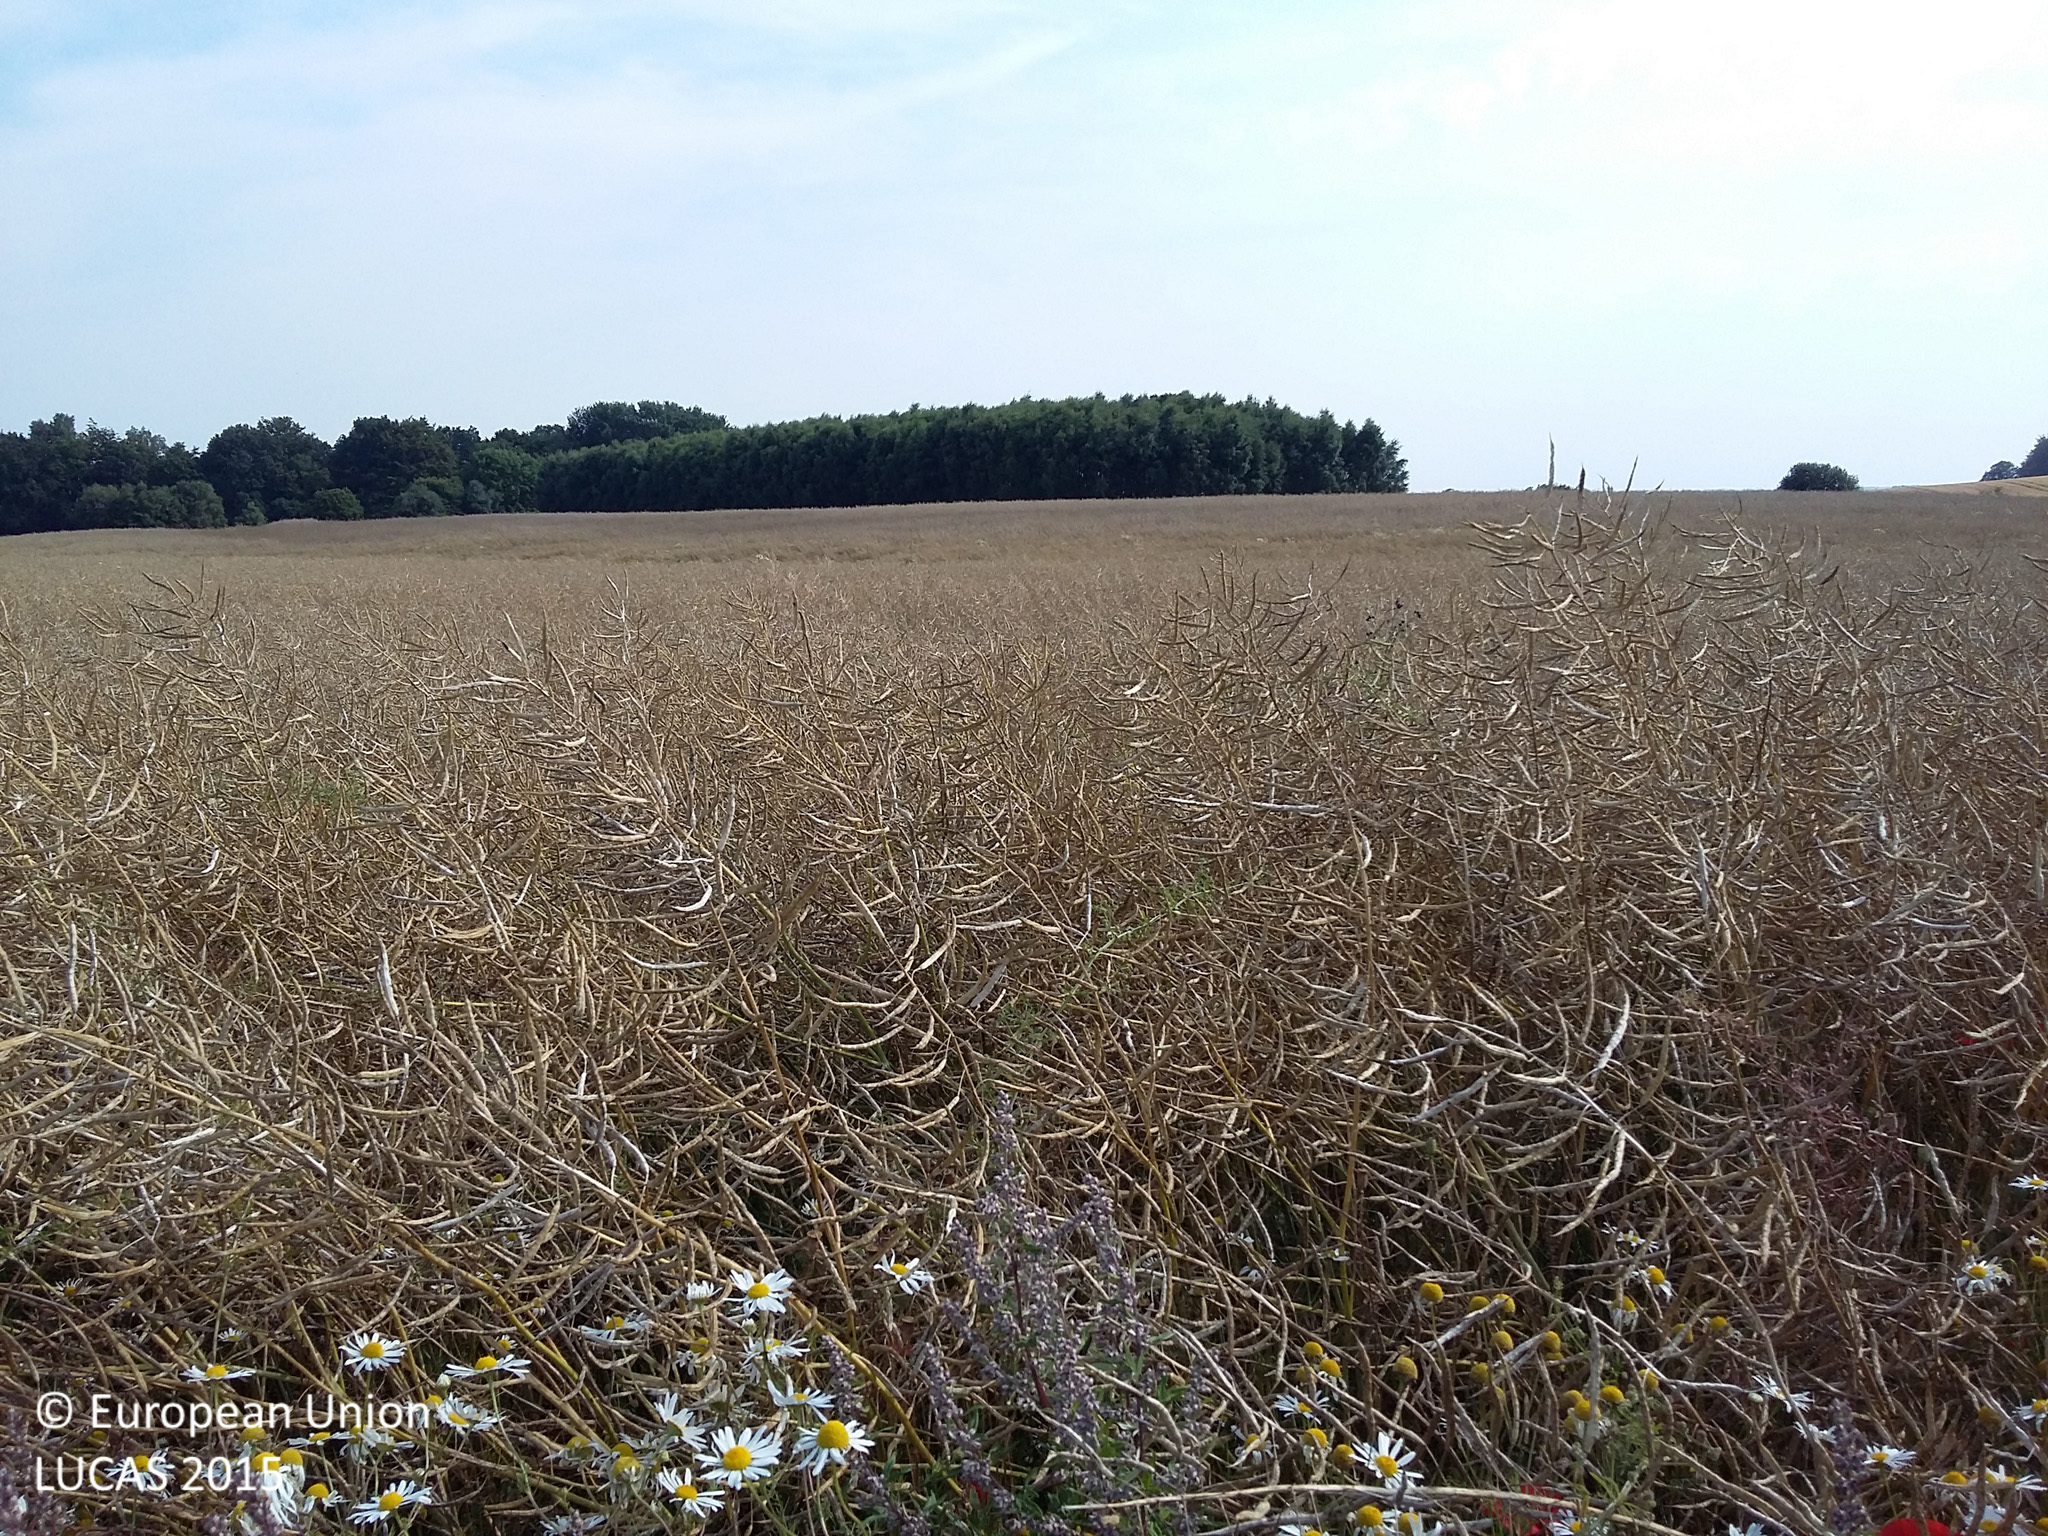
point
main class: Cropland
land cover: Rape and turnip rape
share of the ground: > 75 %
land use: Agriculture (excluding fallow land and kitchen gardens)
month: August
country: DK
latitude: 55.5082
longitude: 11.9143
